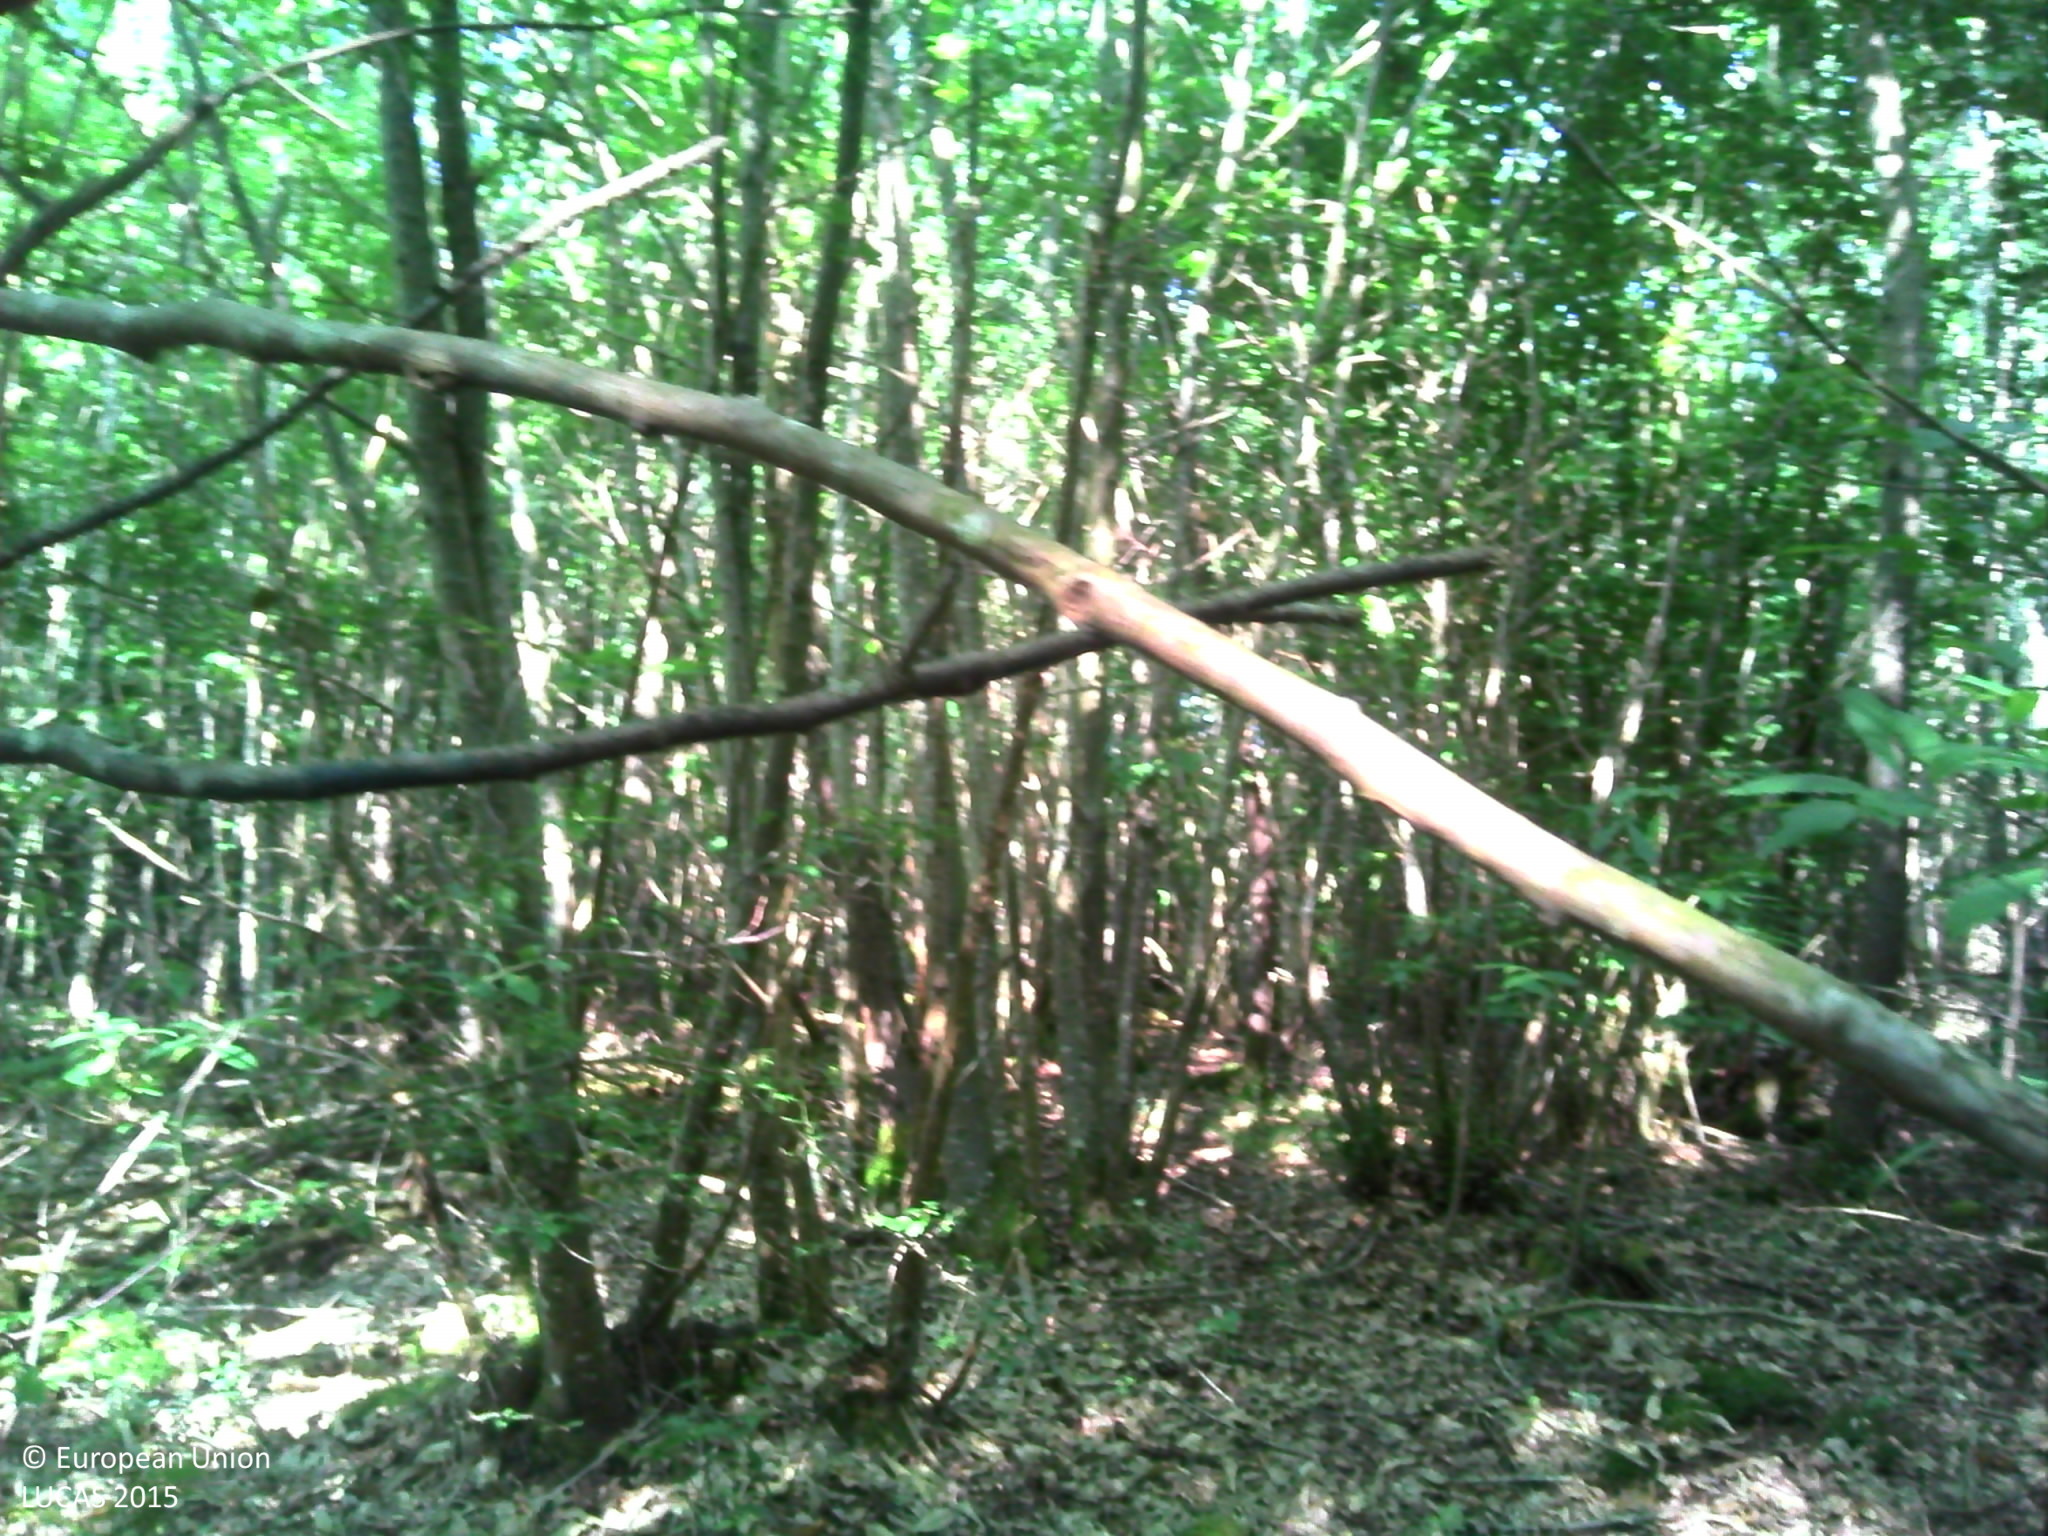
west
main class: Woodland
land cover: Broadleaved woodland
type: beech forest
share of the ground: > 75 %
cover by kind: broadleaved forest trees 70 %, herbaceous plants 20 %, lichens and mosses 10 %
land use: Forestry
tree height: > 5 m
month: June
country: FR
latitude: 47.7707
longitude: 0.0322
